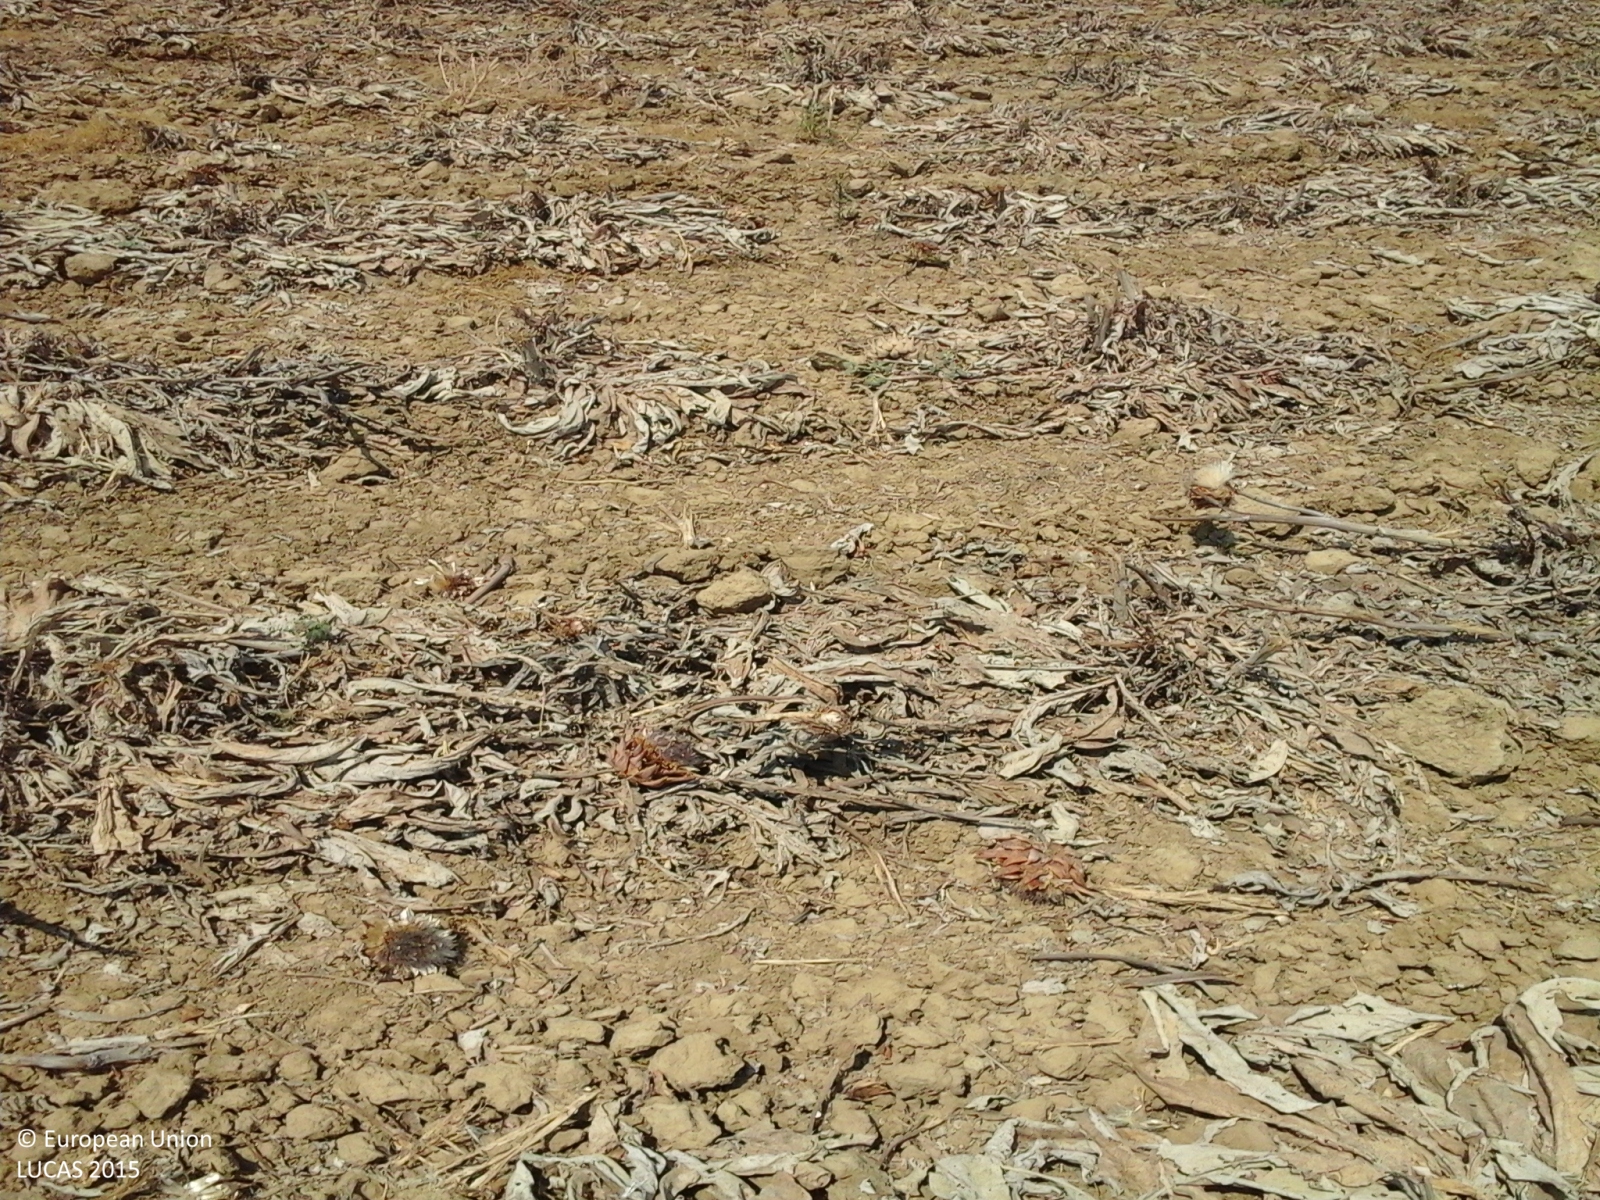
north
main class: Cropland
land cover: Other fresh vegetables
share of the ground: > 75 %
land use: Agriculture (excluding fallow land and kitchen gardens)
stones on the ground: < 10 %
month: July
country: IT
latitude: 37.1733
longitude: 14.3922
